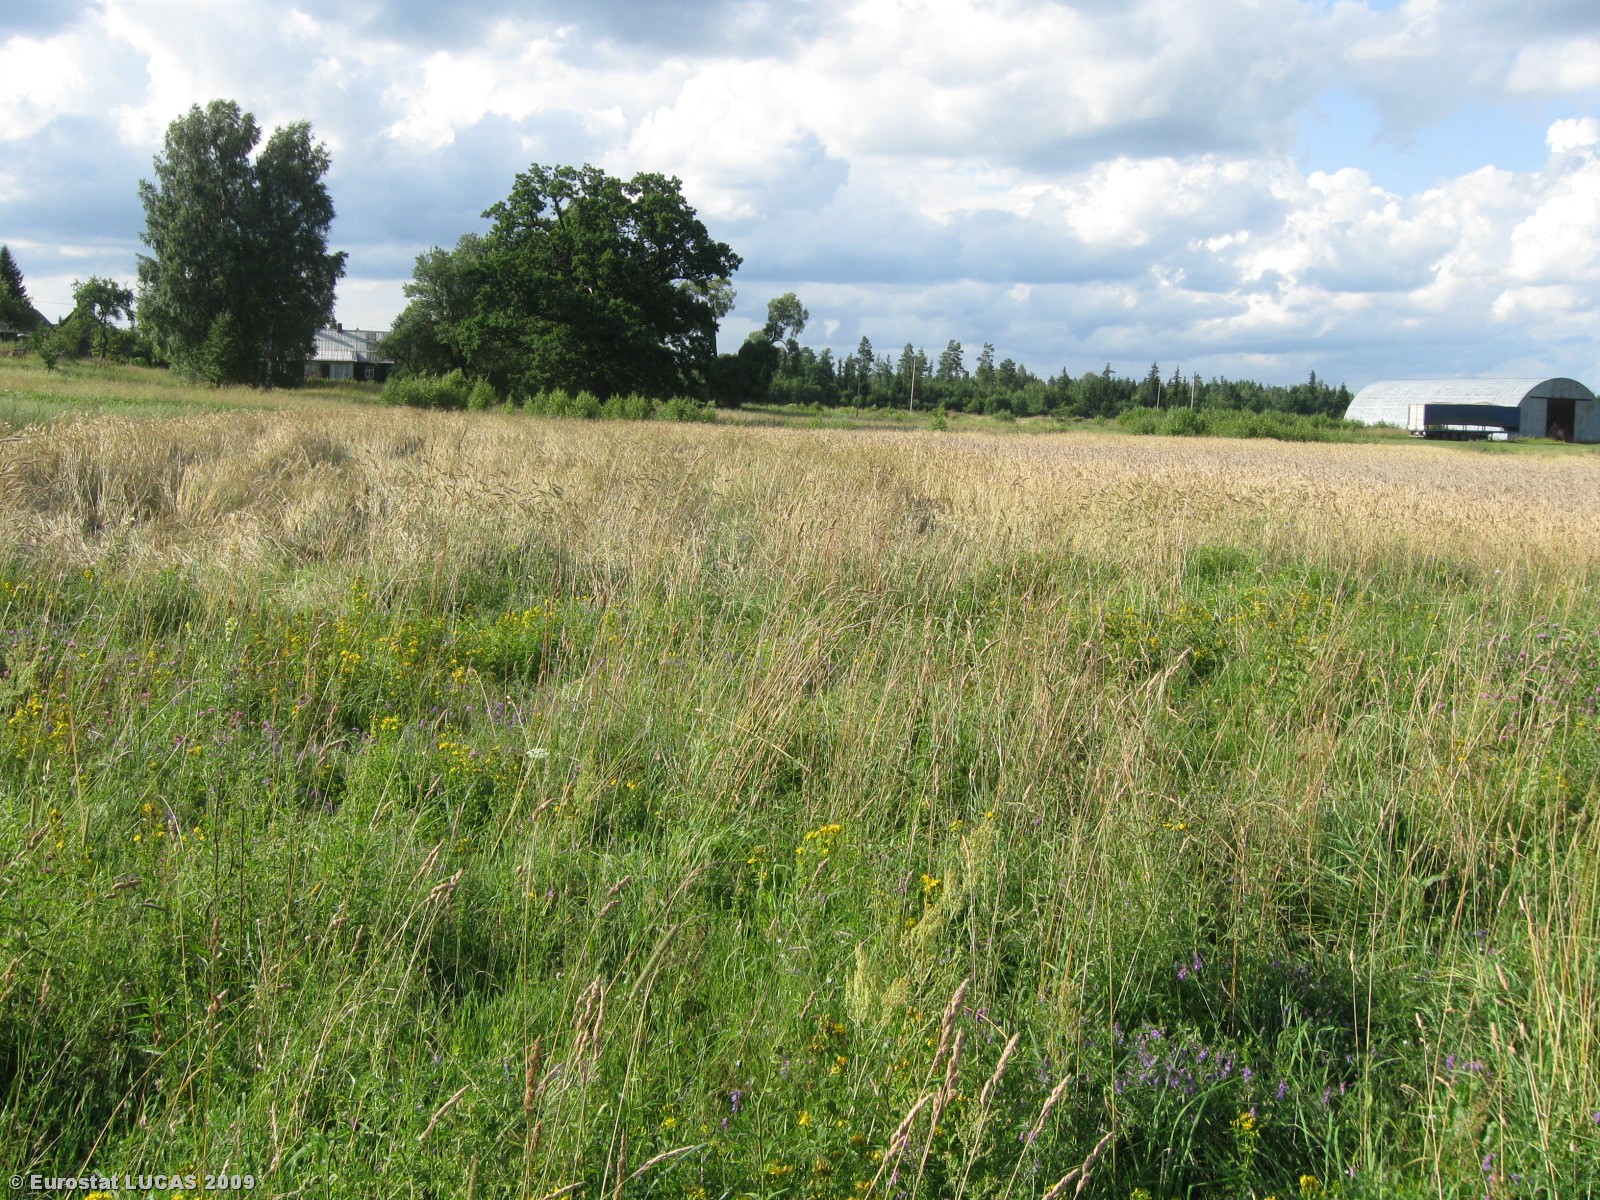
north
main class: Grassland
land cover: Grassland without tree/shrub cover
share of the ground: > 75 %
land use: Agriculture (excluding fallow land and kitchen gardens)
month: July
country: LT
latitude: 54.4885
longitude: 25.3285
